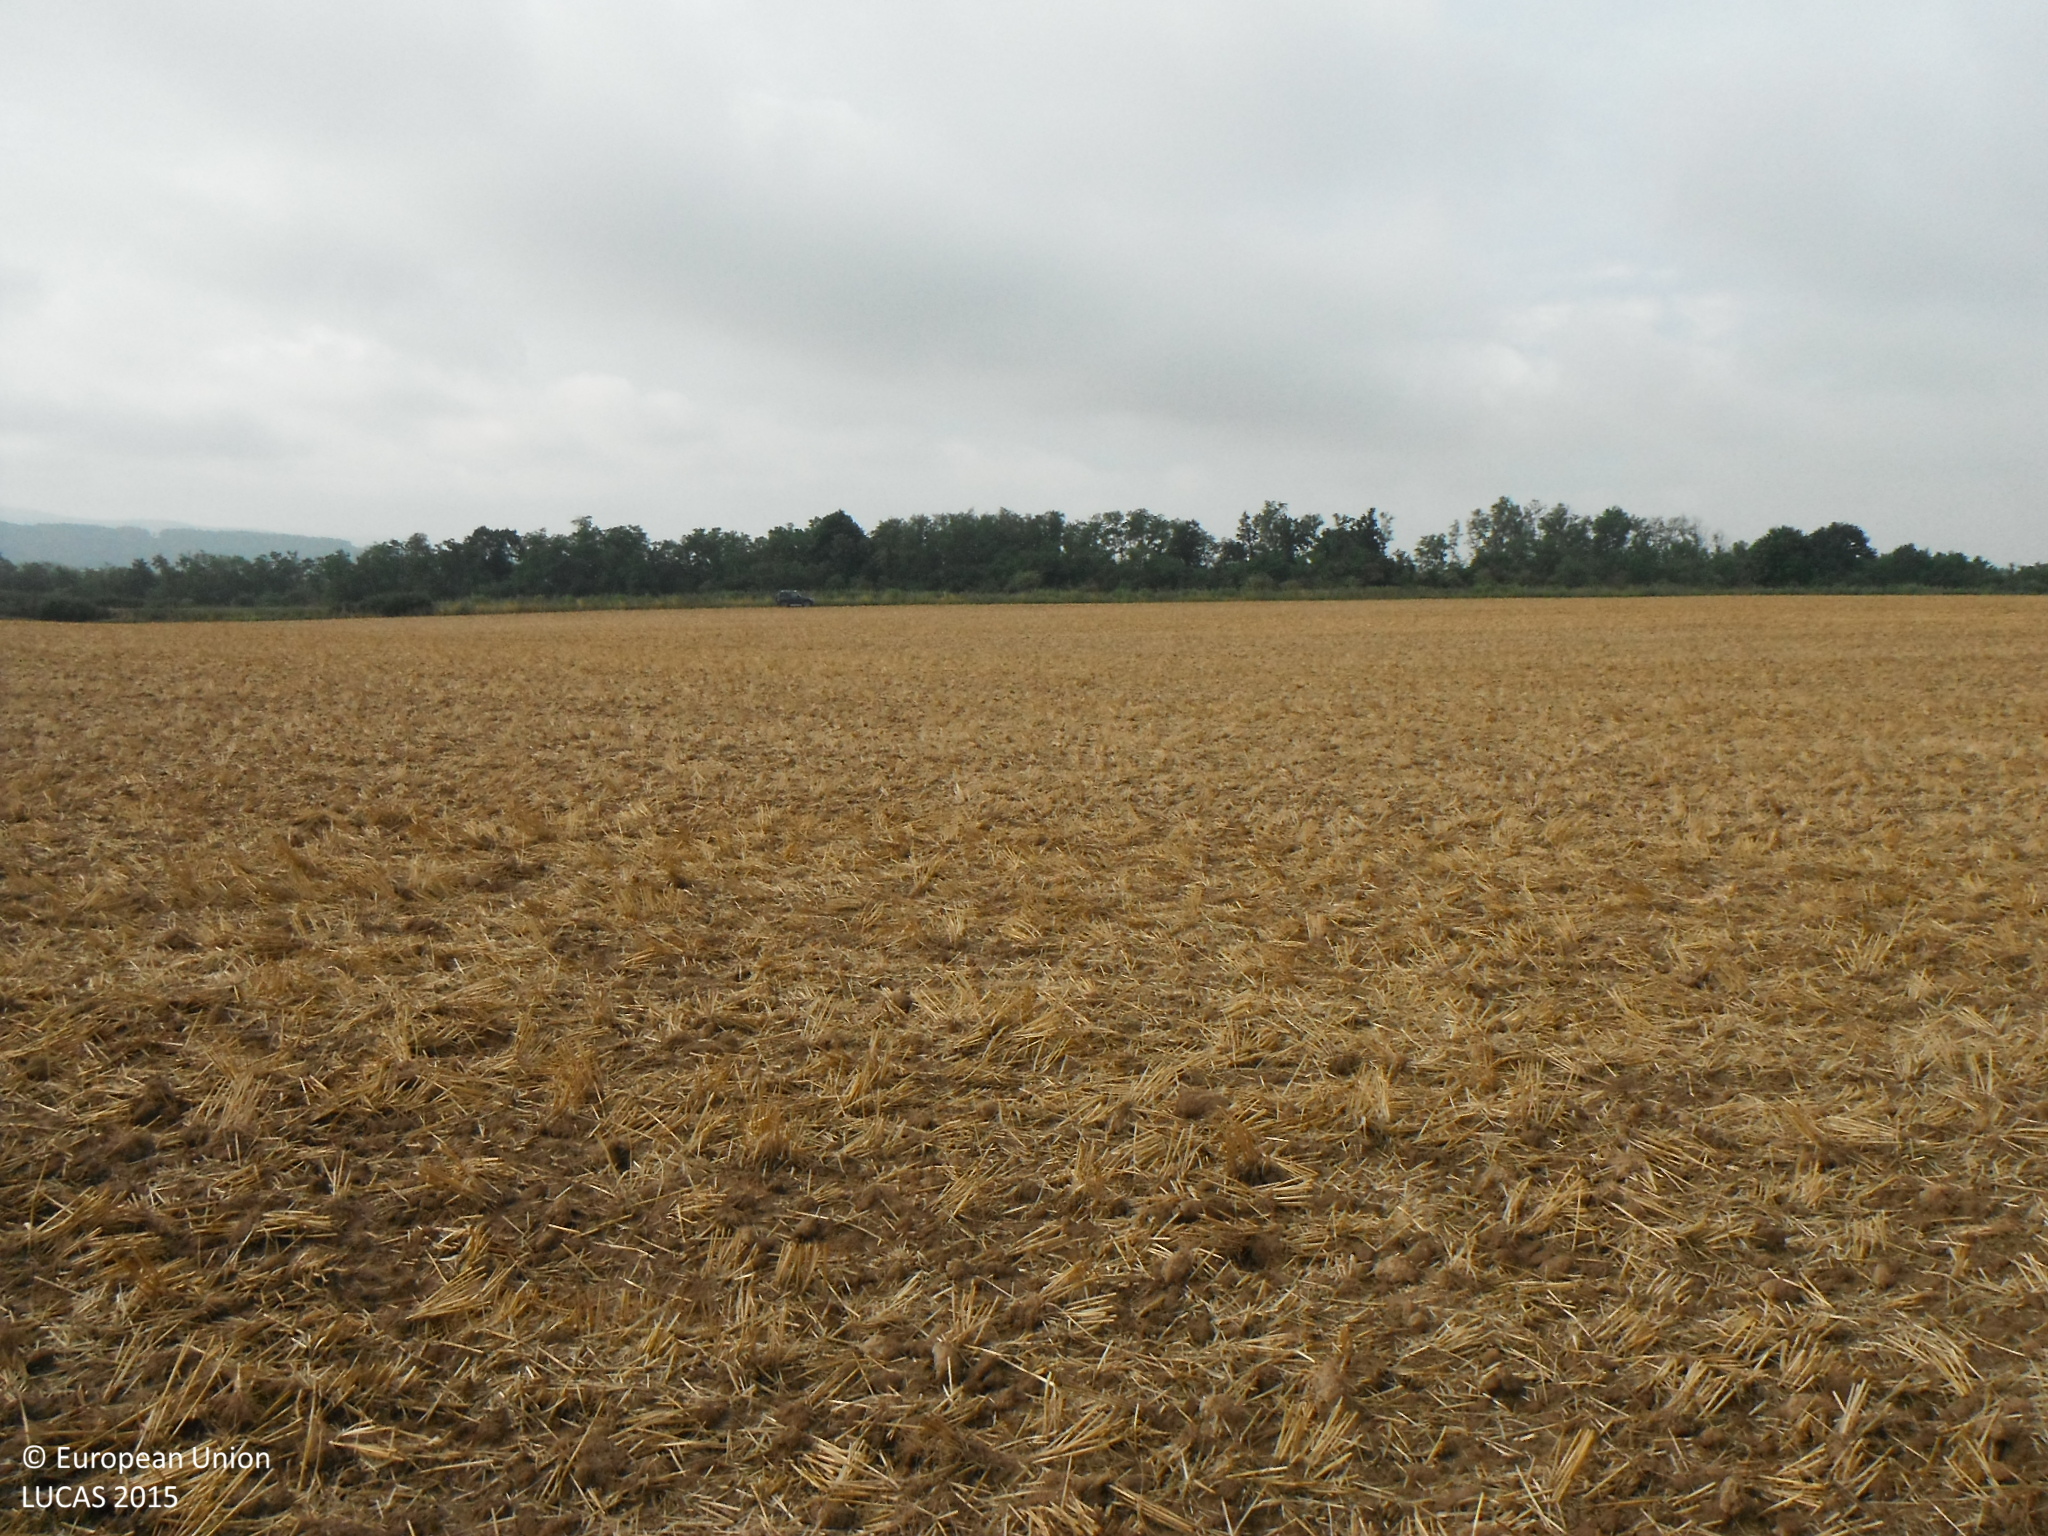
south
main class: Cropland
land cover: Common wheat
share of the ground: 50 - 75 %
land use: Agriculture (excluding fallow land and kitchen gardens)
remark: Harvested field
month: July
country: SK
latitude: 48.3469
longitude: 19.8098
